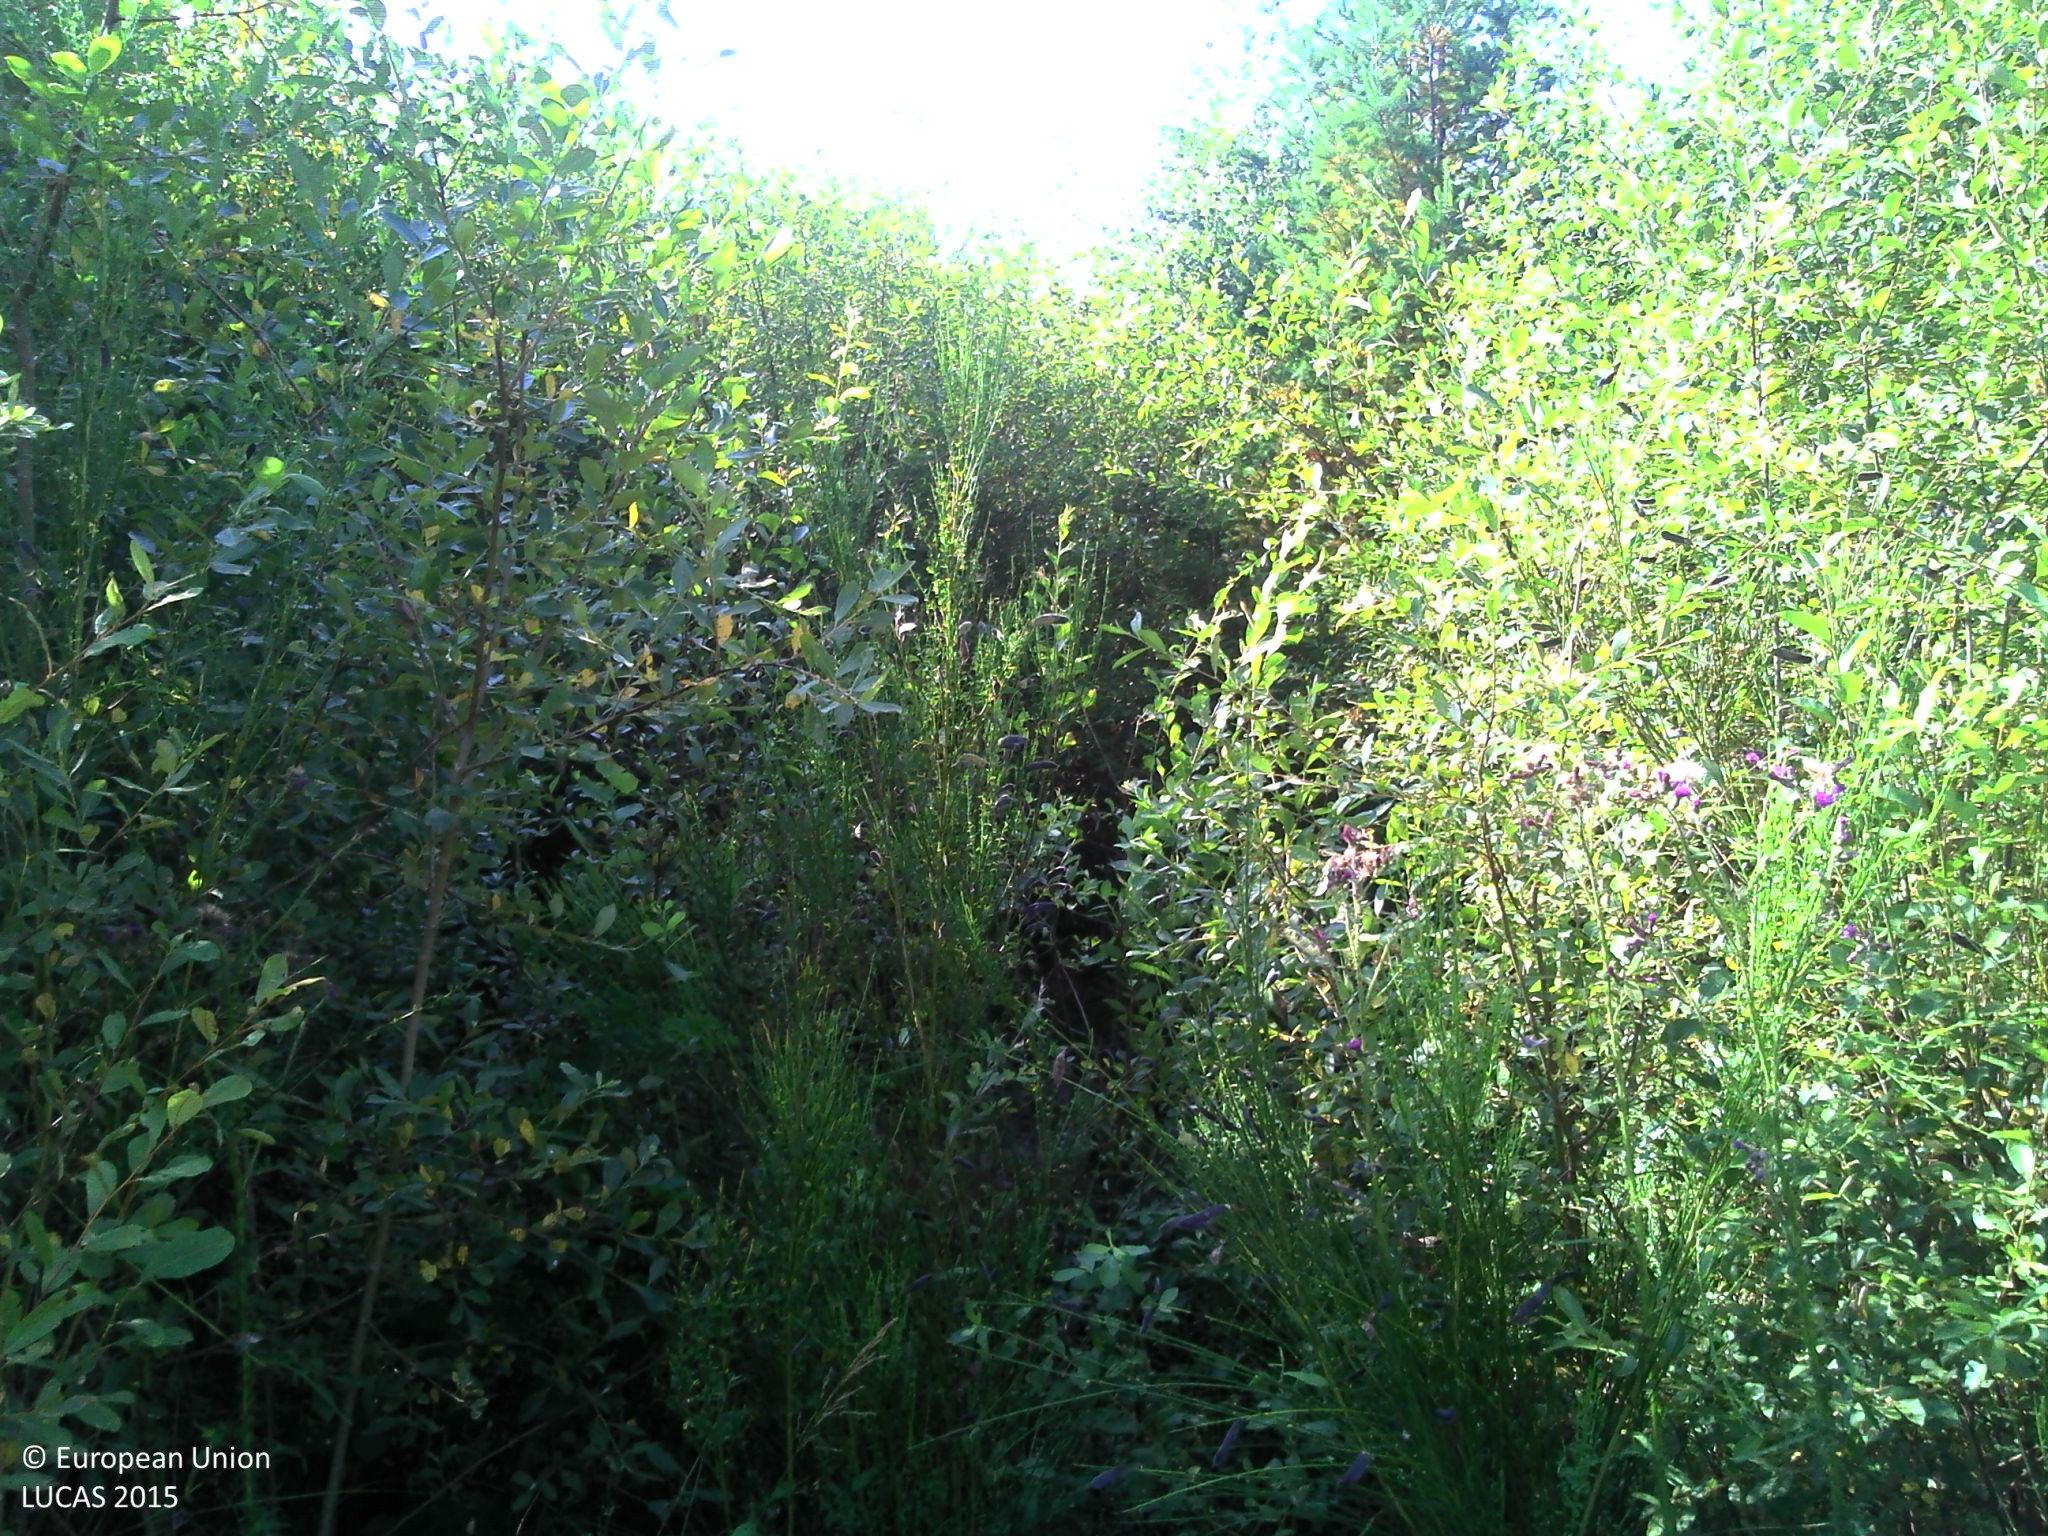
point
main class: Woodland
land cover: Pine dominated coniferous woodland
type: hemiboreal forest and nemoral coniferous forest and mixed broadleaved-coniferous forest
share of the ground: > 75 %
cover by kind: coniferous forest trees 75 %, broadleaved forest trees 25 %
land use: Forestry
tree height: > 5 m
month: July
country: FR
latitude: 45.9973
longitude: 1.7683
